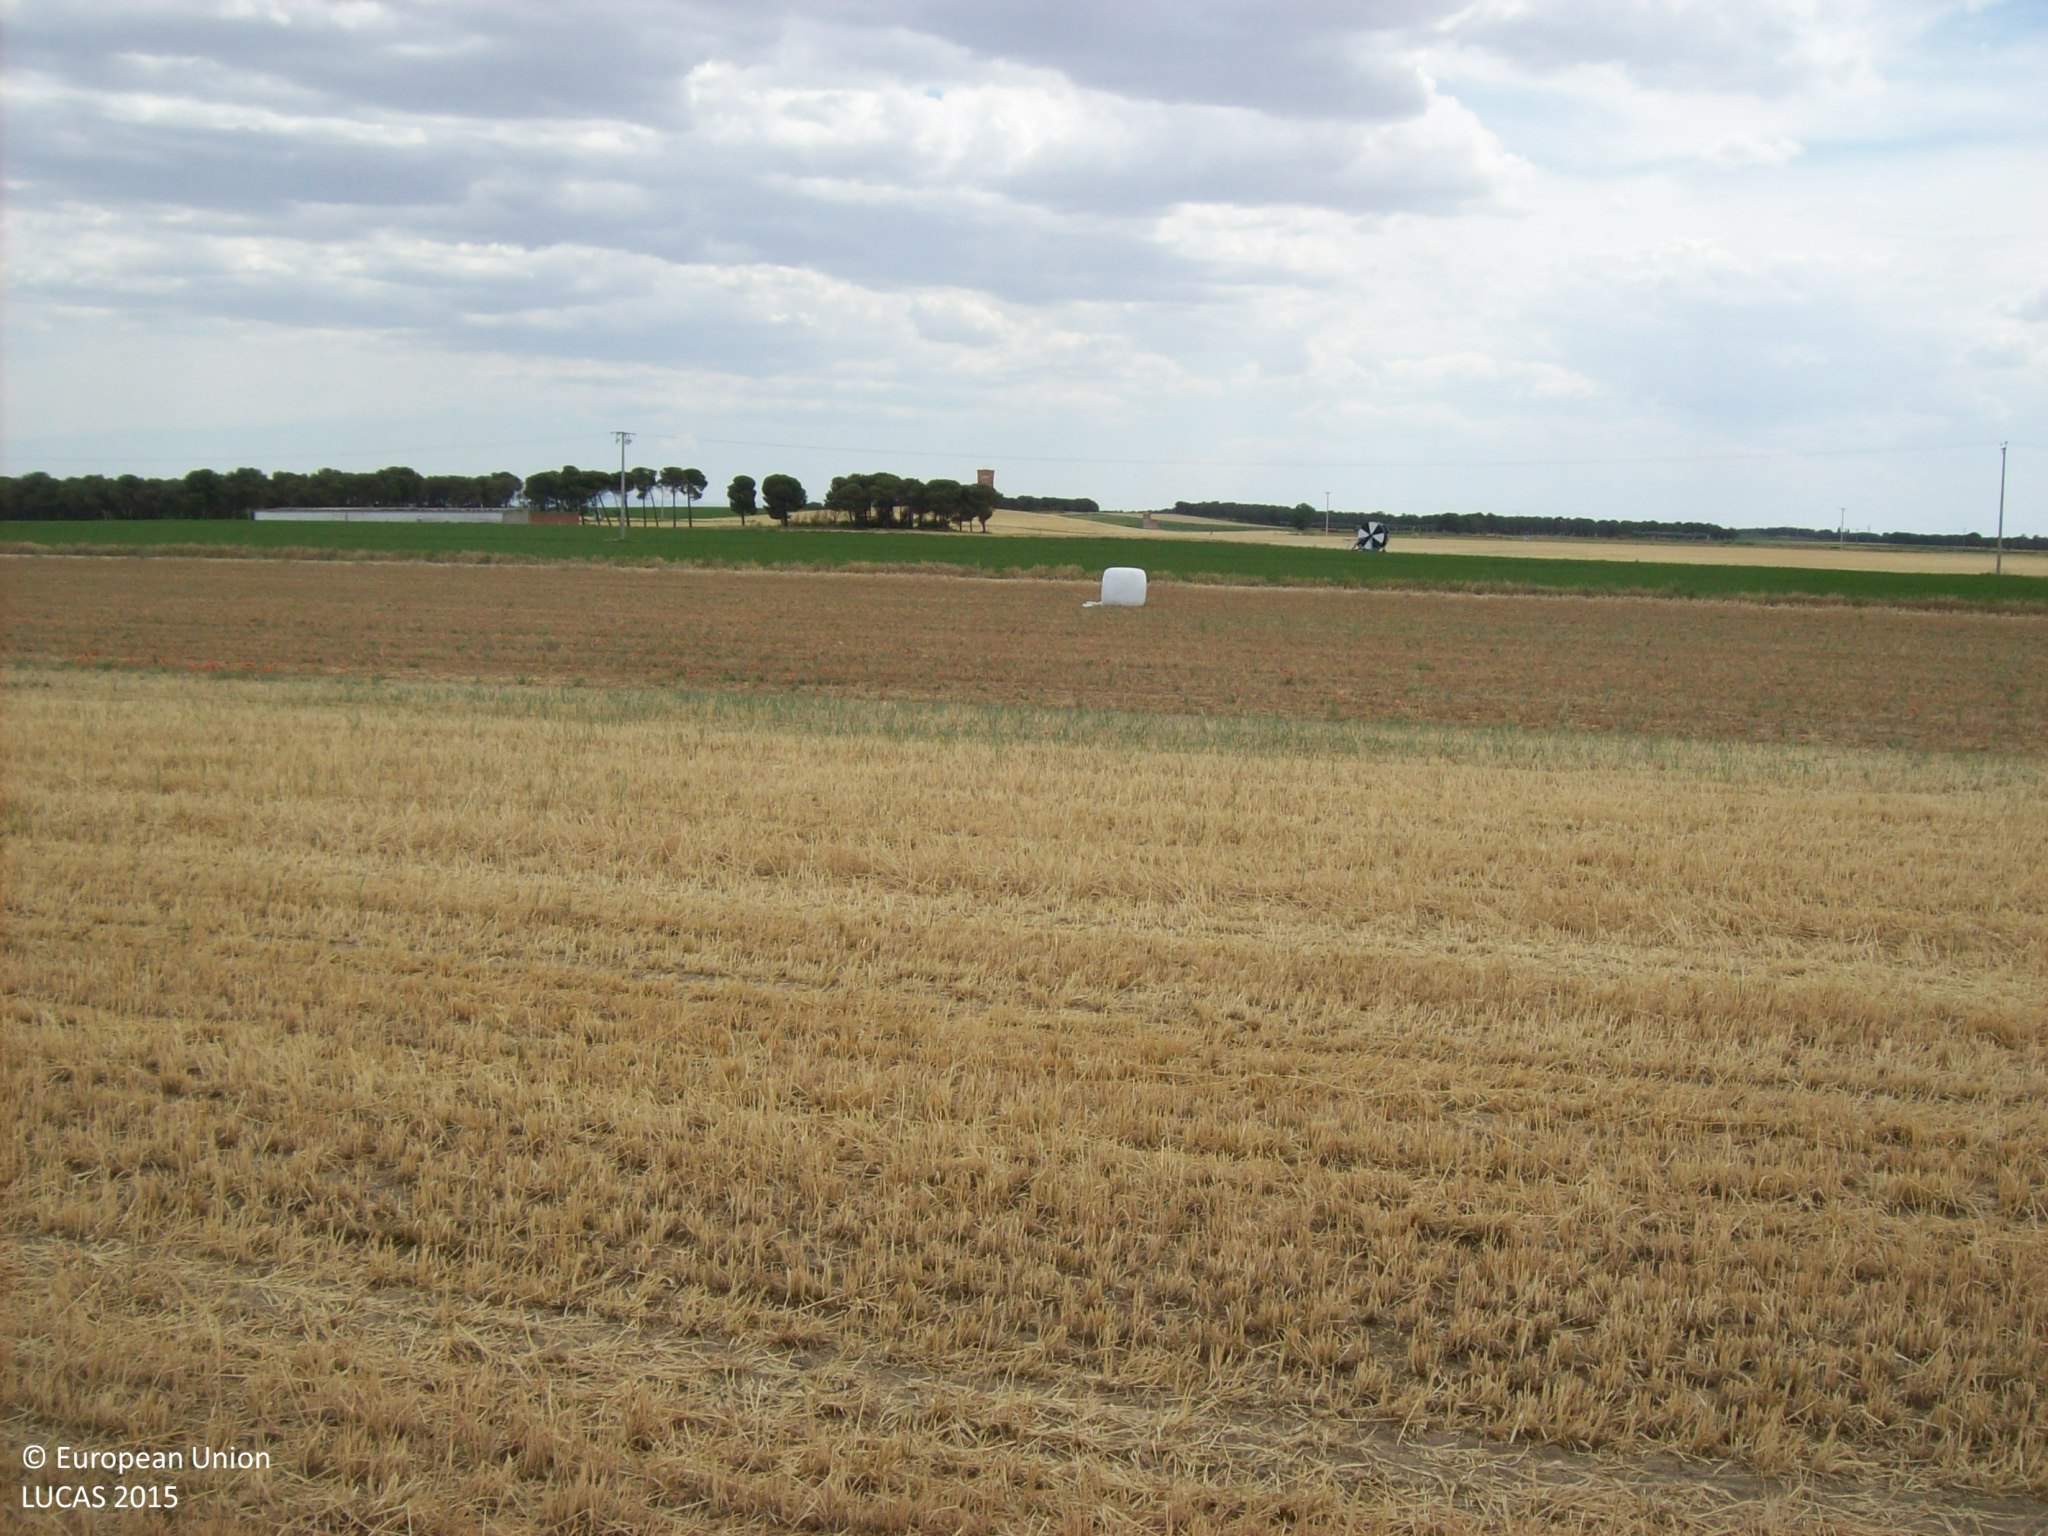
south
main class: Cropland
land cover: Mixed cereals for fodder
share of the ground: < 10 %
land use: Agriculture (excluding fallow land and kitchen gardens)
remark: Harvested field
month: June
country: ES
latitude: 41.1981
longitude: -5.0093
